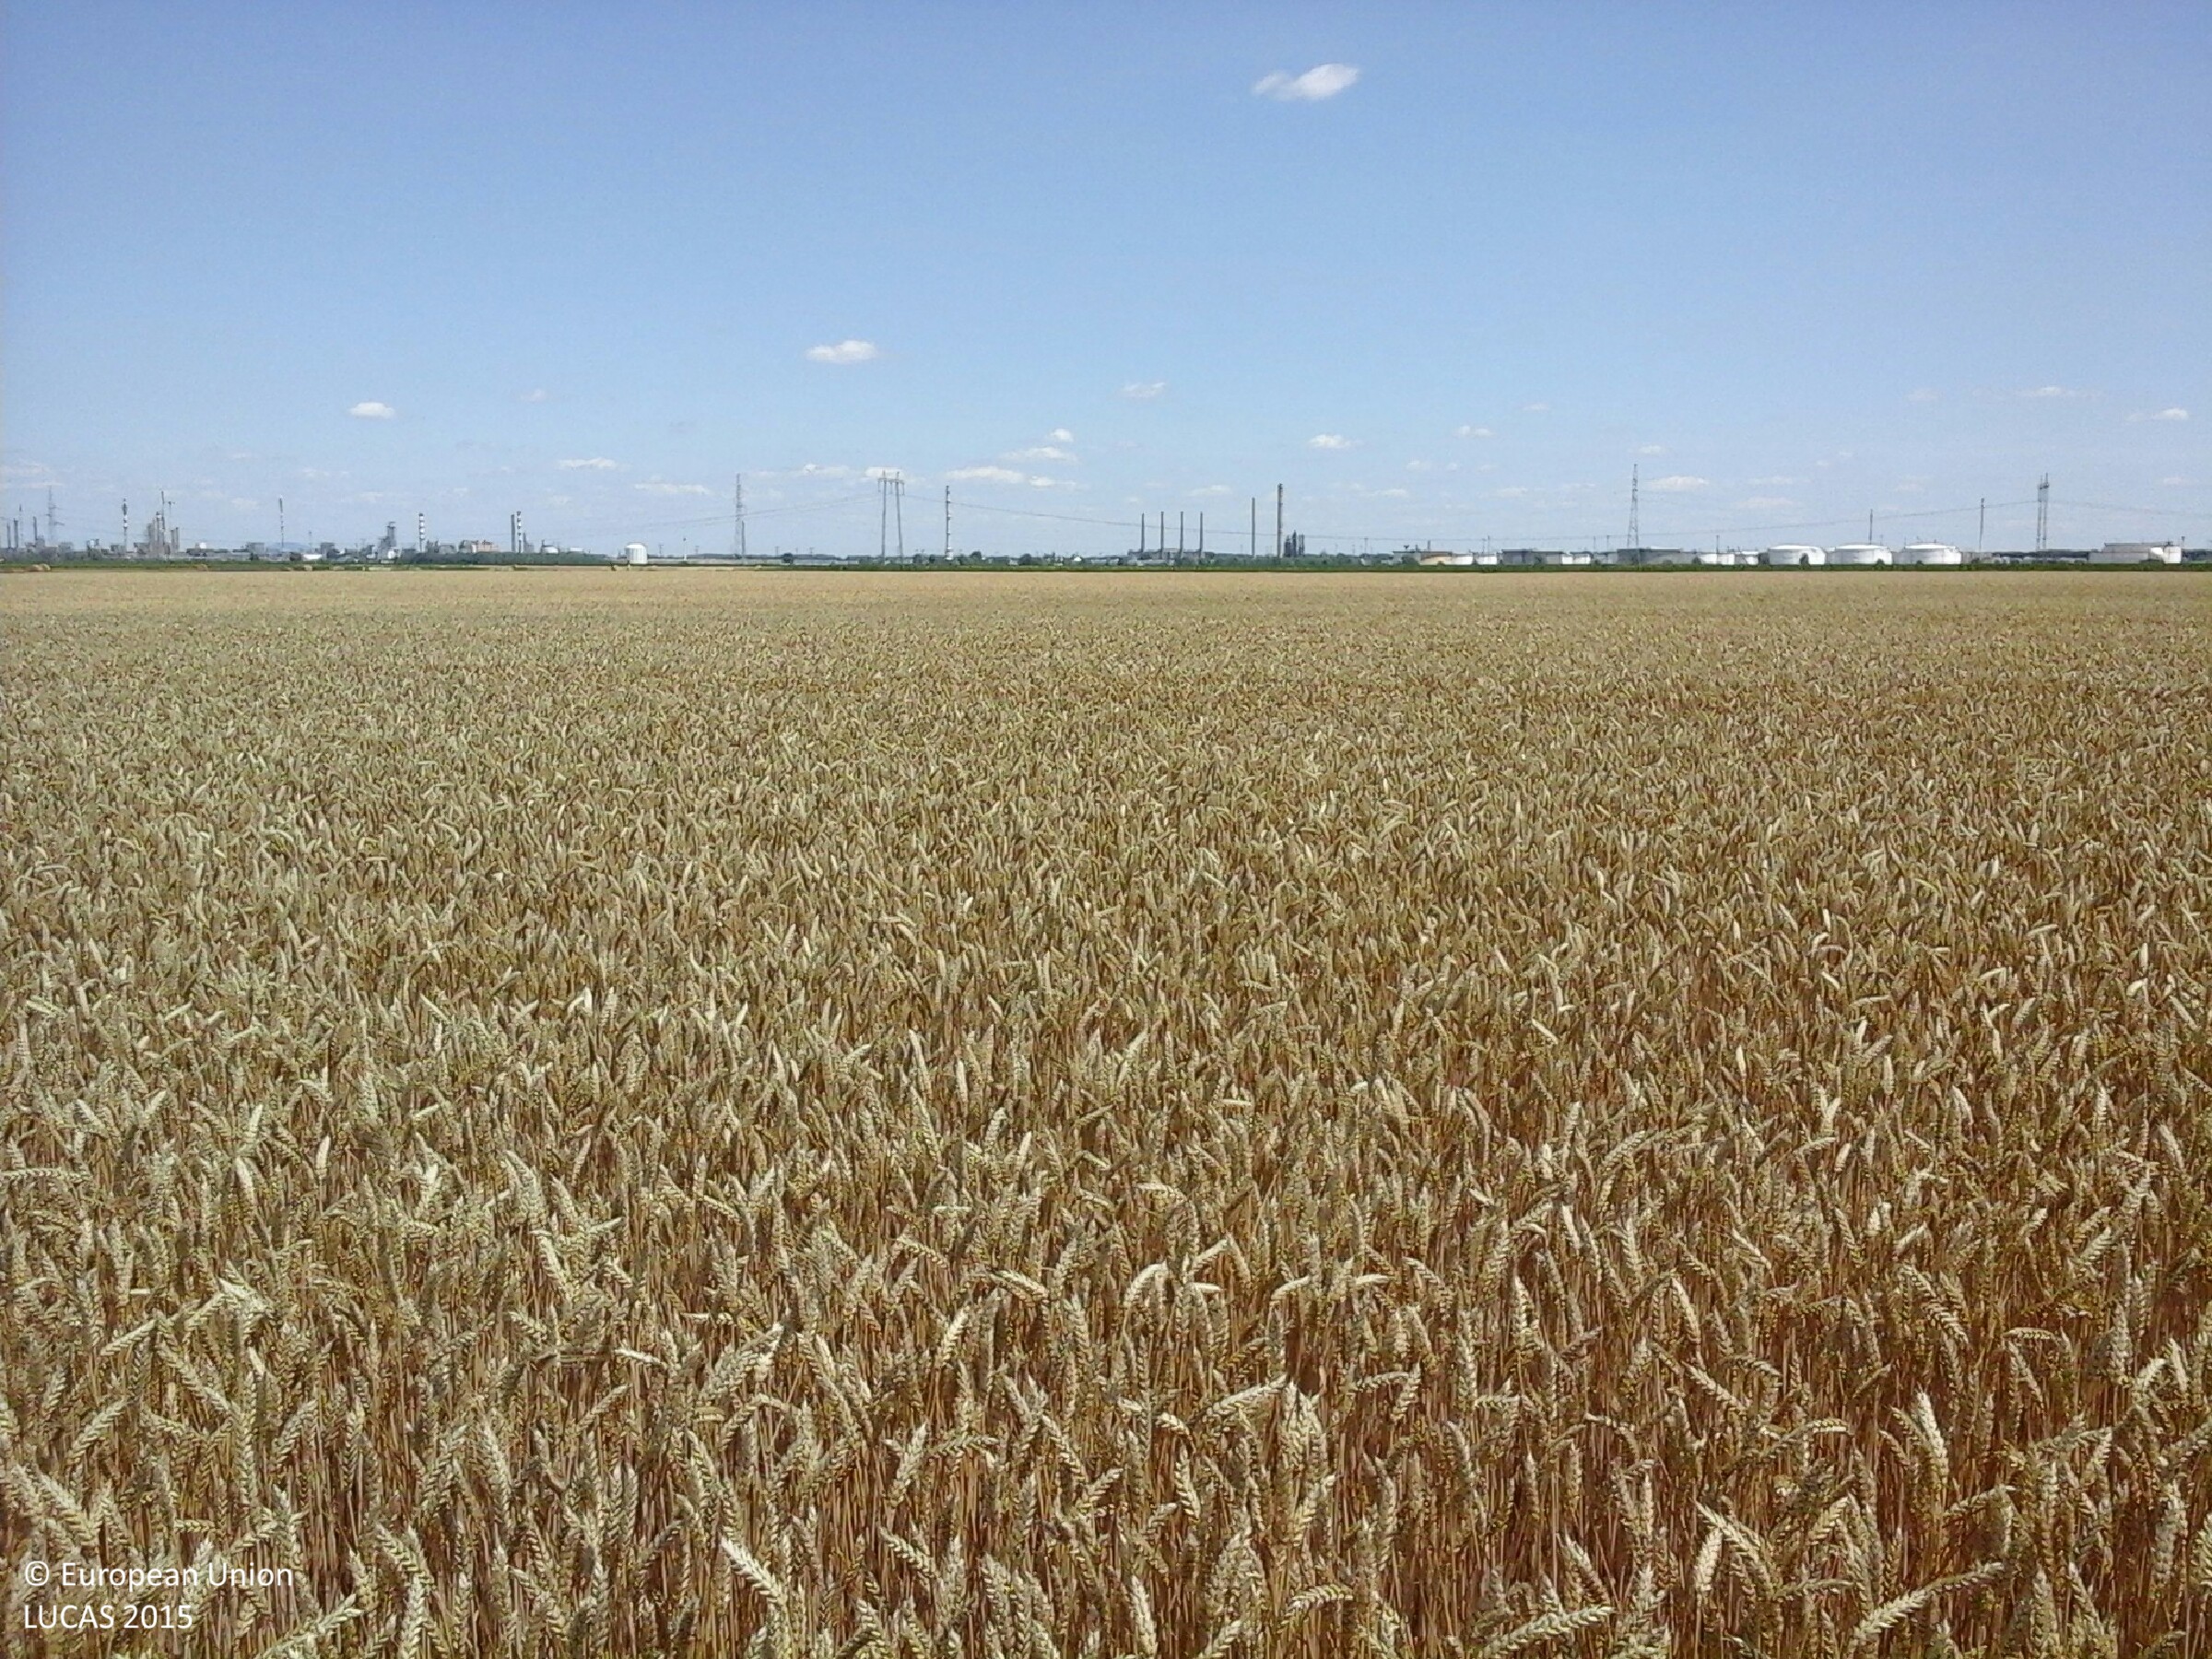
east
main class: Cropland
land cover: Common wheat
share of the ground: > 75 %
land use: Agriculture (excluding fallow land and kitchen gardens)
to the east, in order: Common wheat
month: July
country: HU
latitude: 47.8900
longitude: 20.9918
